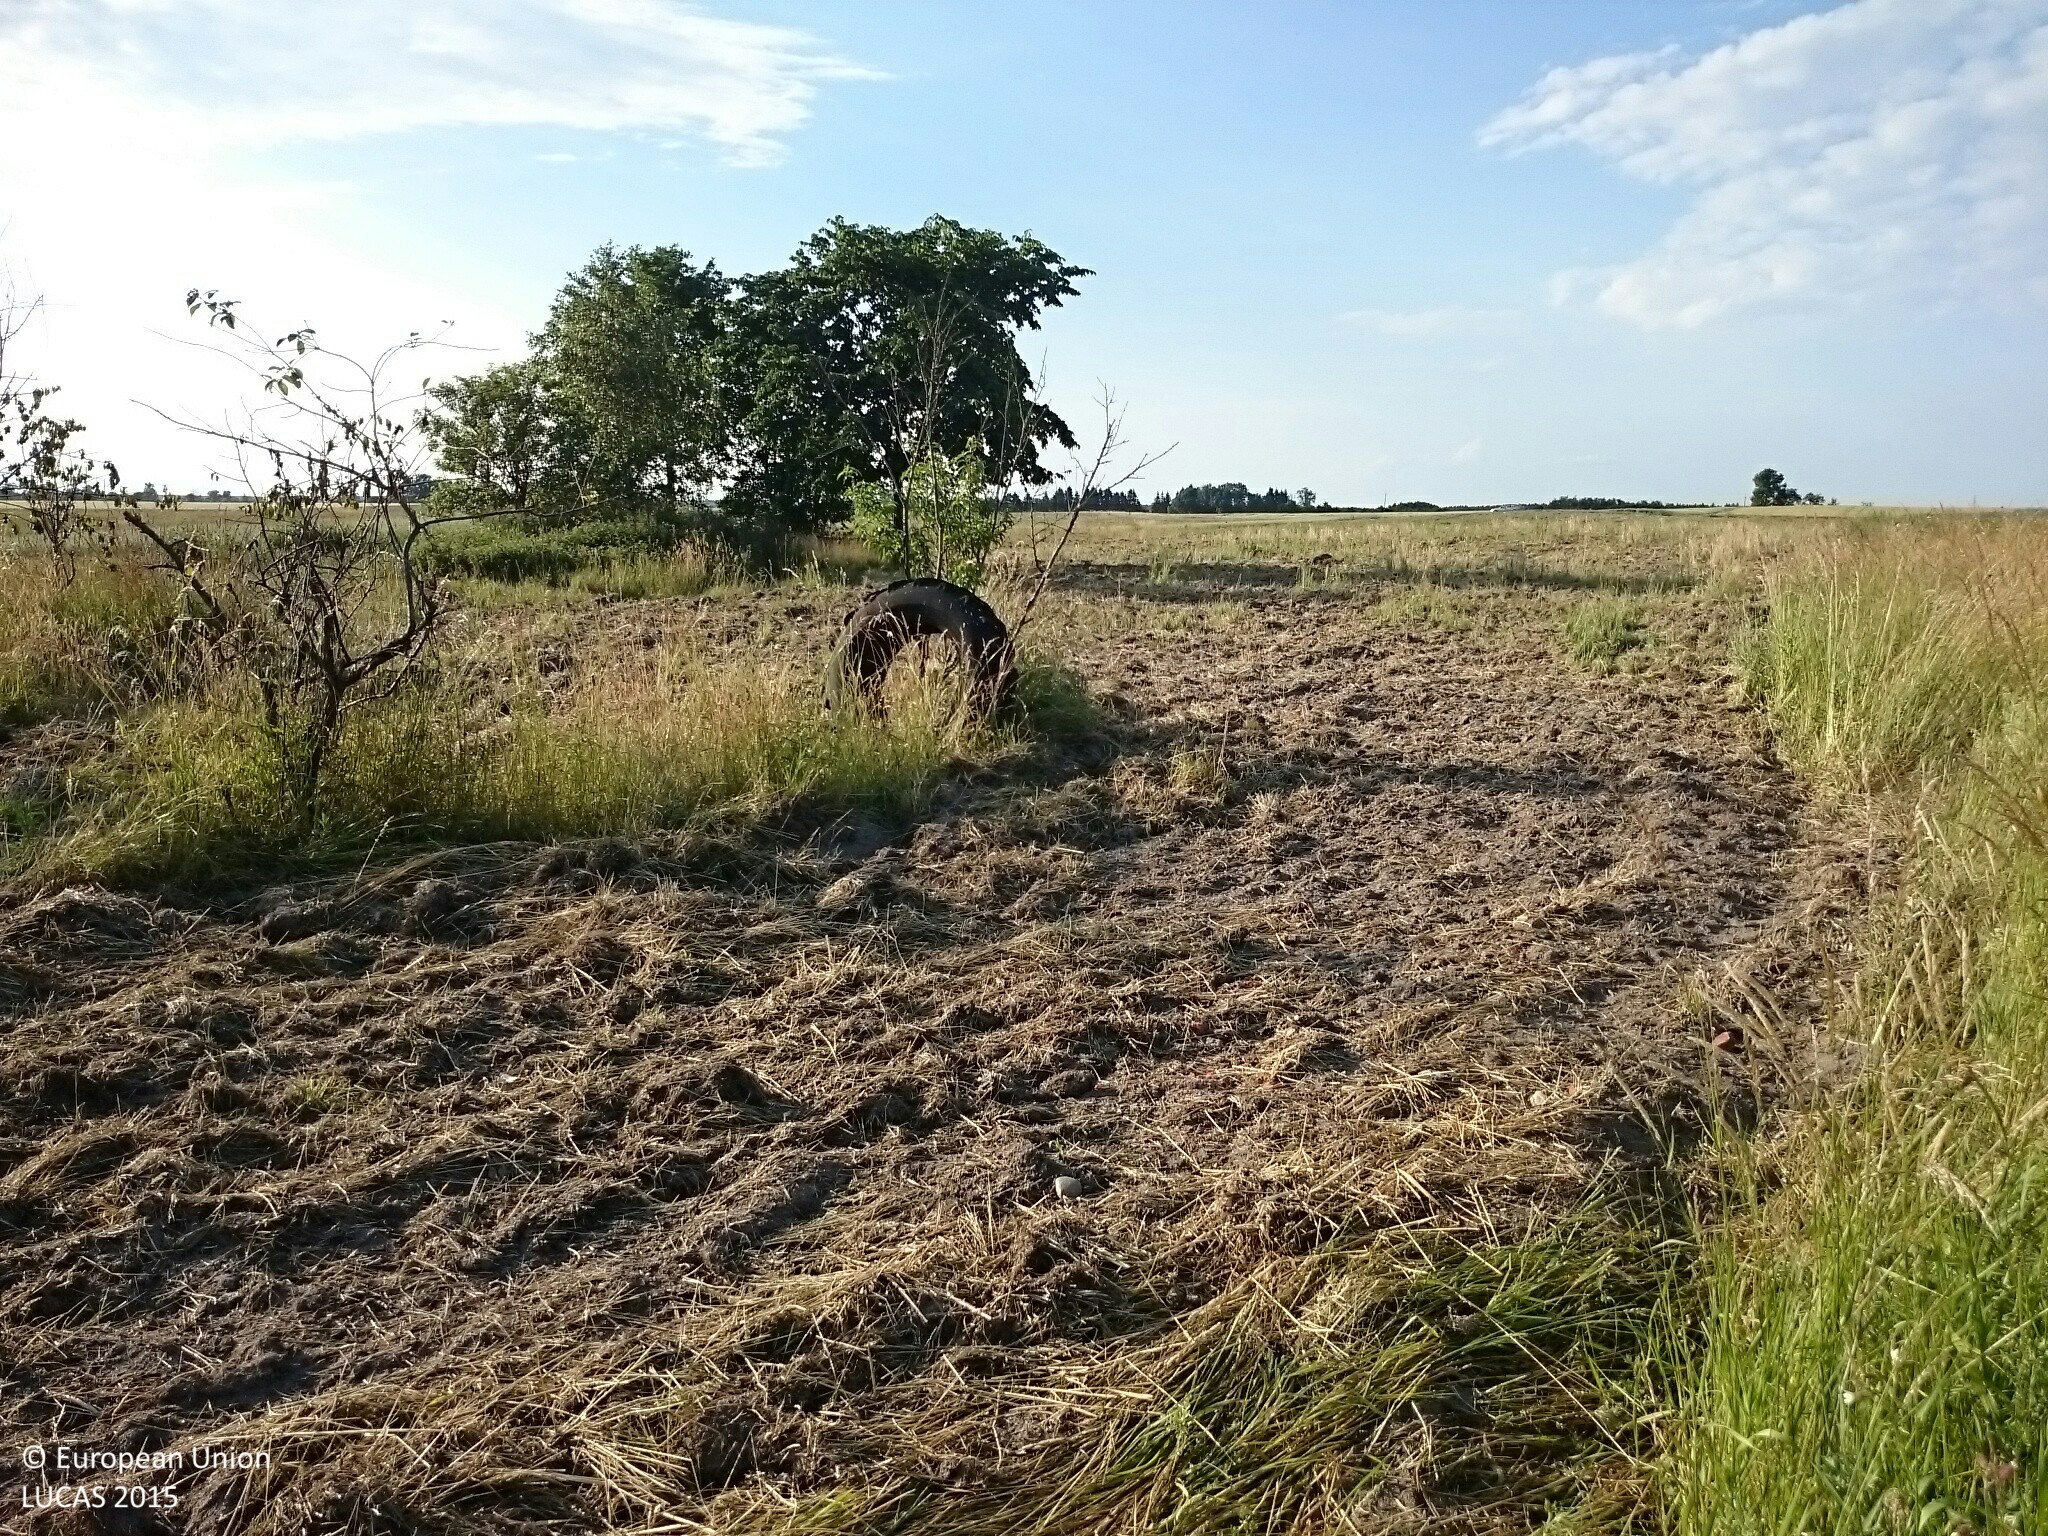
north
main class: Grassland
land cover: Grassland without tree/shrub cover
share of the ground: > 75 %
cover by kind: herbaceous plants 90 %, unconsolidated bare surface 10 %
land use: Agriculture (excluding fallow land and kitchen gardens)
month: June
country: PL
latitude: 53.0342
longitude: 15.6858
